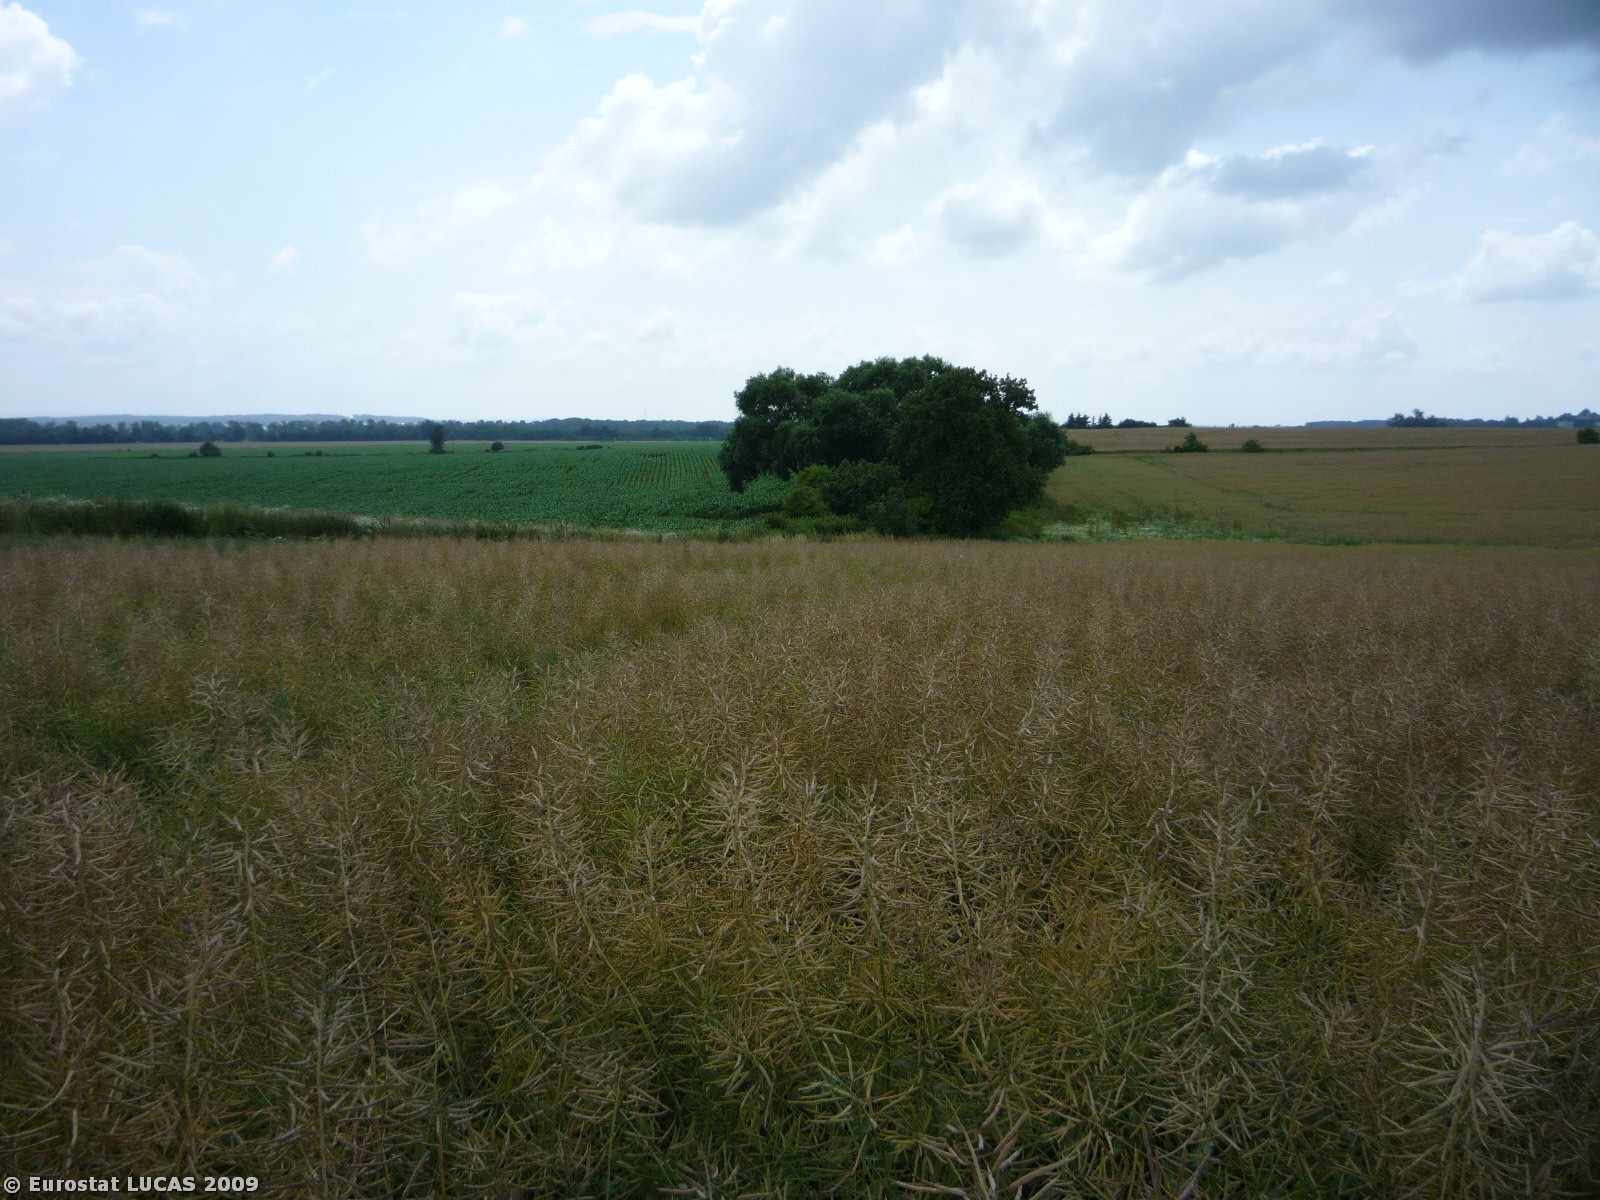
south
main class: Cropland
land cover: Rape and turnip rape
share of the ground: > 75 %
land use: Agriculture (excluding fallow land and kitchen gardens)
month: June
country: CZ
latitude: 50.1787
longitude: 15.4793
